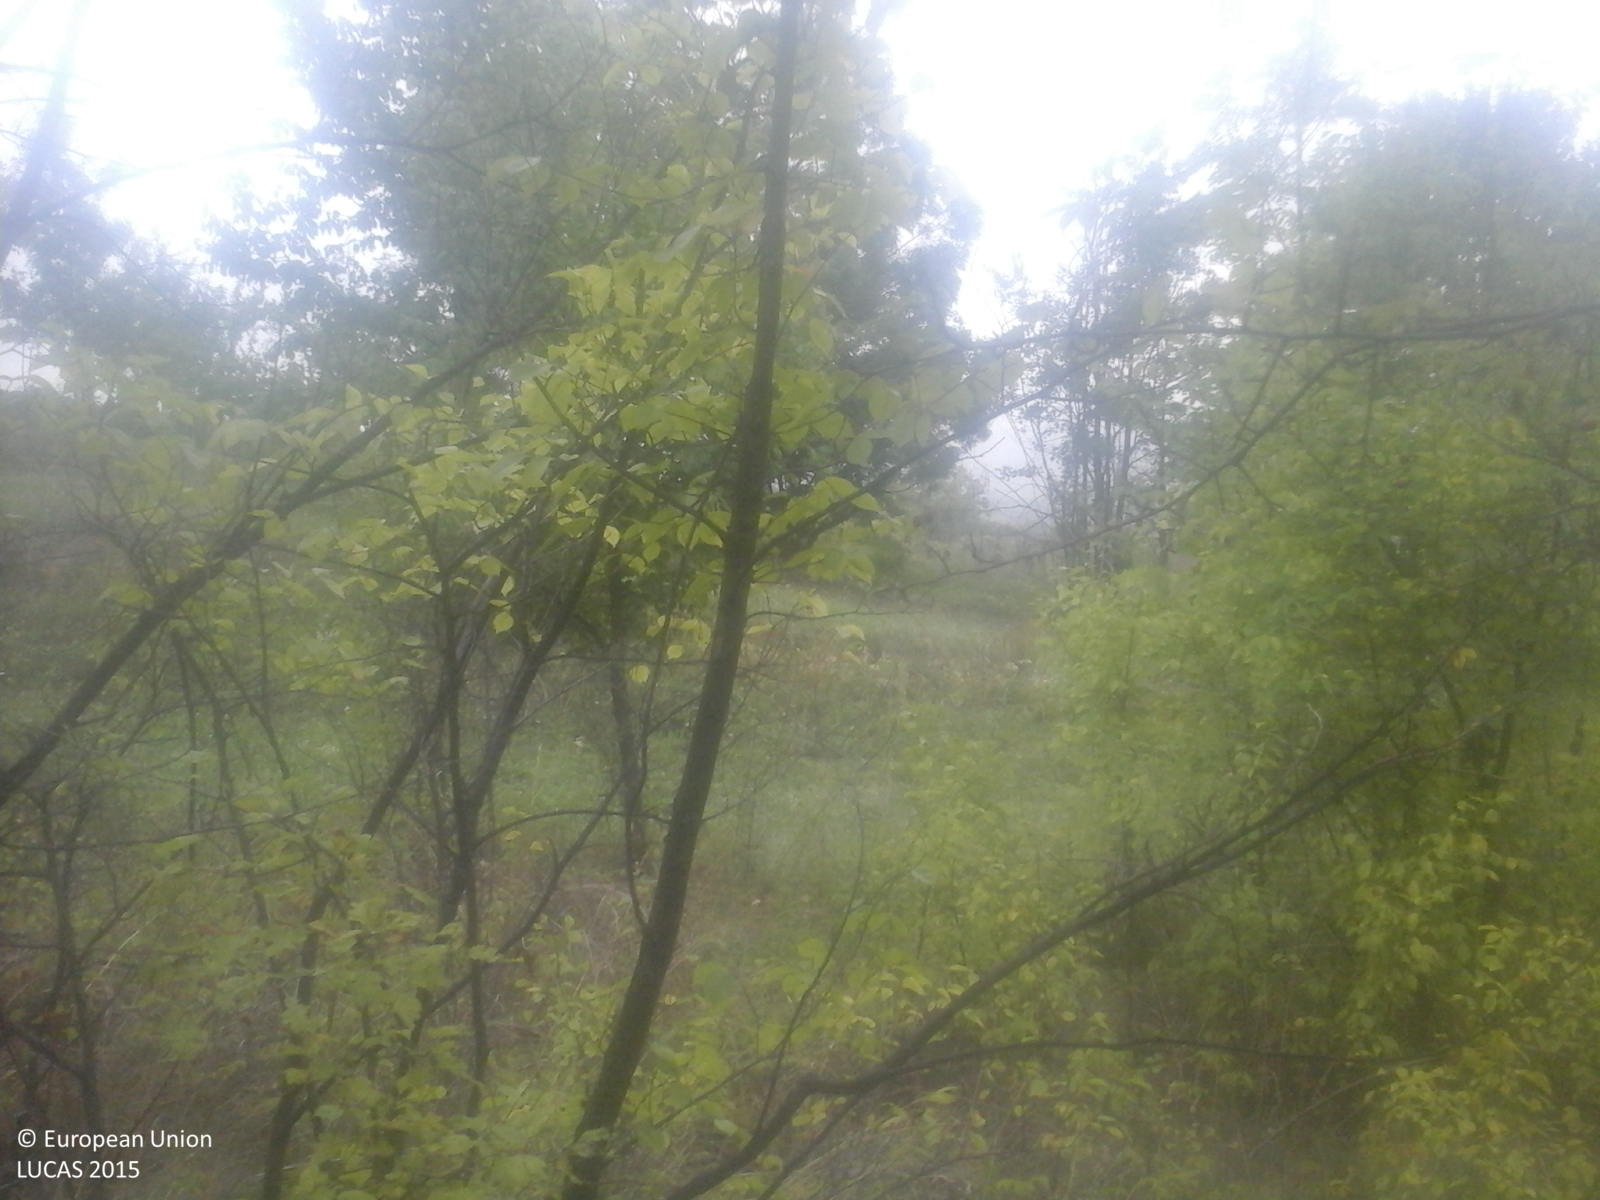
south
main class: Woodland
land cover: Broadleaved woodland
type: beech forest
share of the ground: > 75 %
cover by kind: broadleaved forest trees 100 %
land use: Forestry
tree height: > 5 m
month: September
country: RO
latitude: 44.8041
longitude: 23.1609
